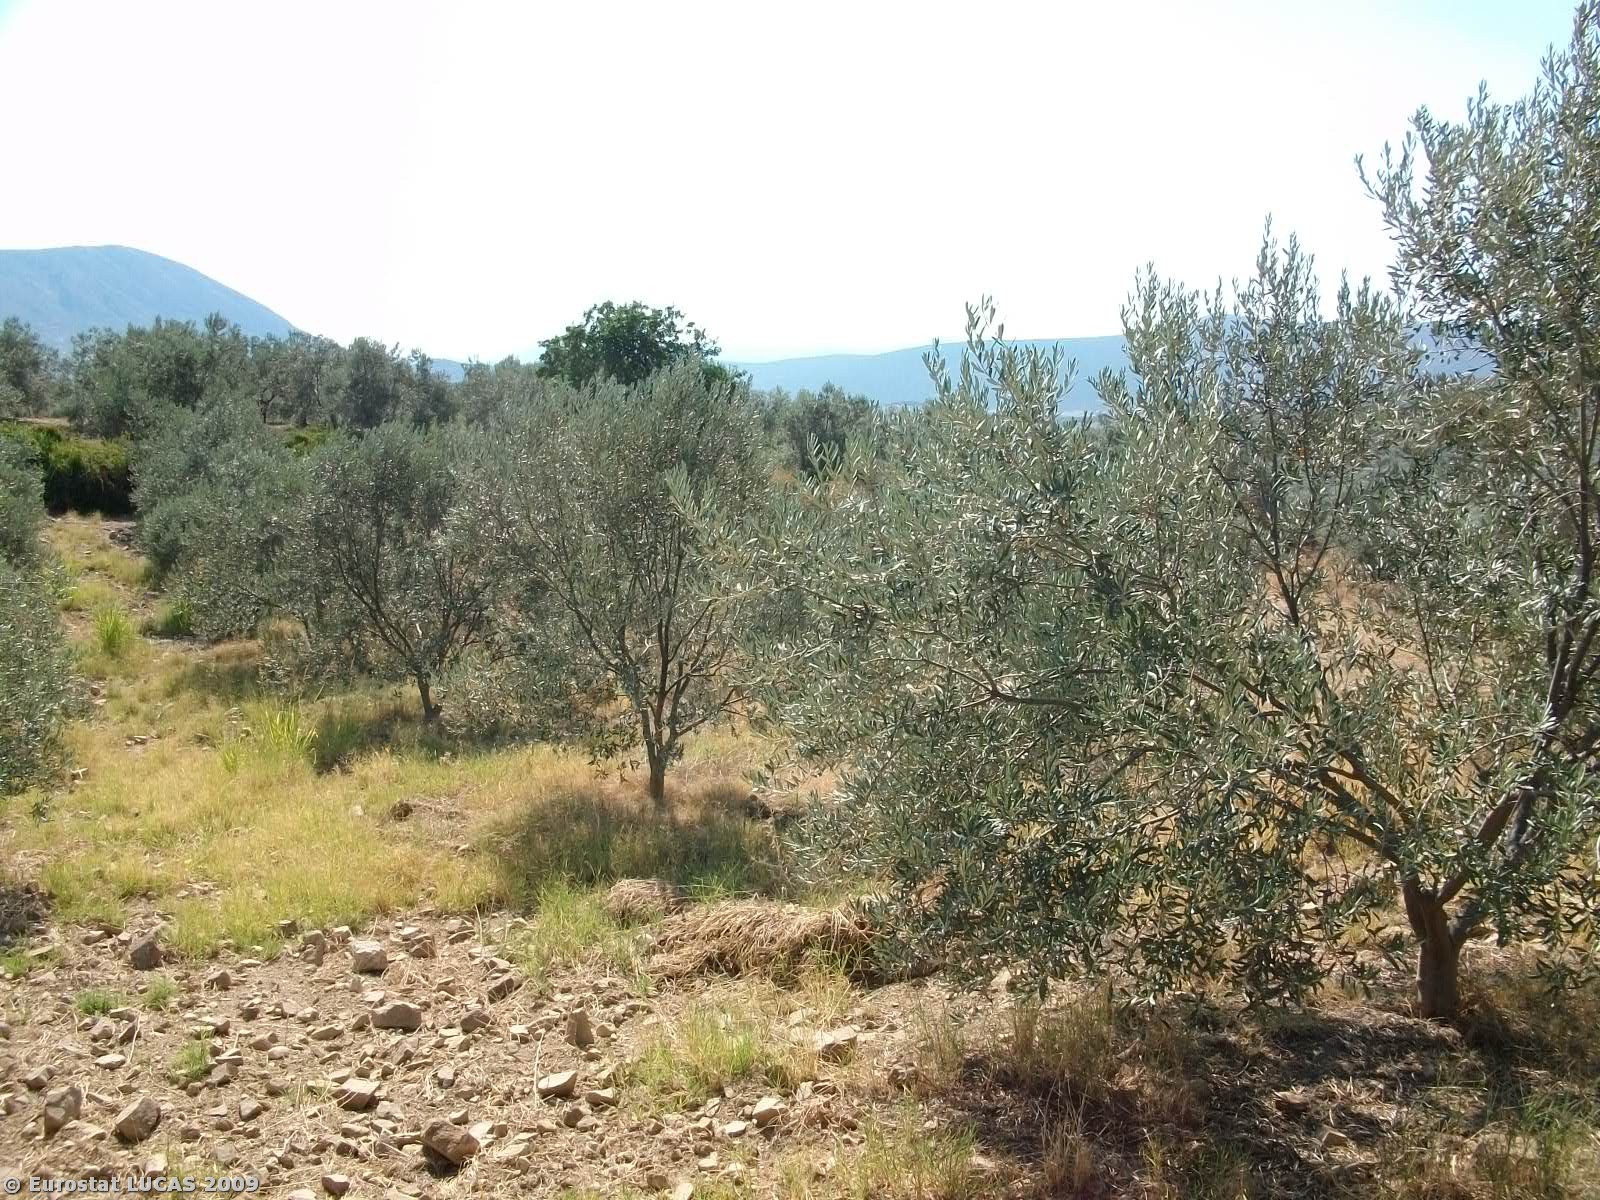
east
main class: Cropland
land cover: Olive groves
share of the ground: 50 - 75 %
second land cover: Grassland with sparse tree/shrub cover
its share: 50 - 75 %
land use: Agriculture (excluding fallow land and kitchen gardens)
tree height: < 5 m
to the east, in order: Olive groves; Grassland with sparse tree/shrub cover; Grass margins; Dry stone walls; Olive groves; Grassland with sparse tree/shrub cover; Ditches and canals; Shrubland with sparse tree cover; Electric lines; Grassland without tree/shrub cover; Olive groves; Grassland with sparse tree/shrub cover
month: July
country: GR
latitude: 37.6146
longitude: 22.9163
